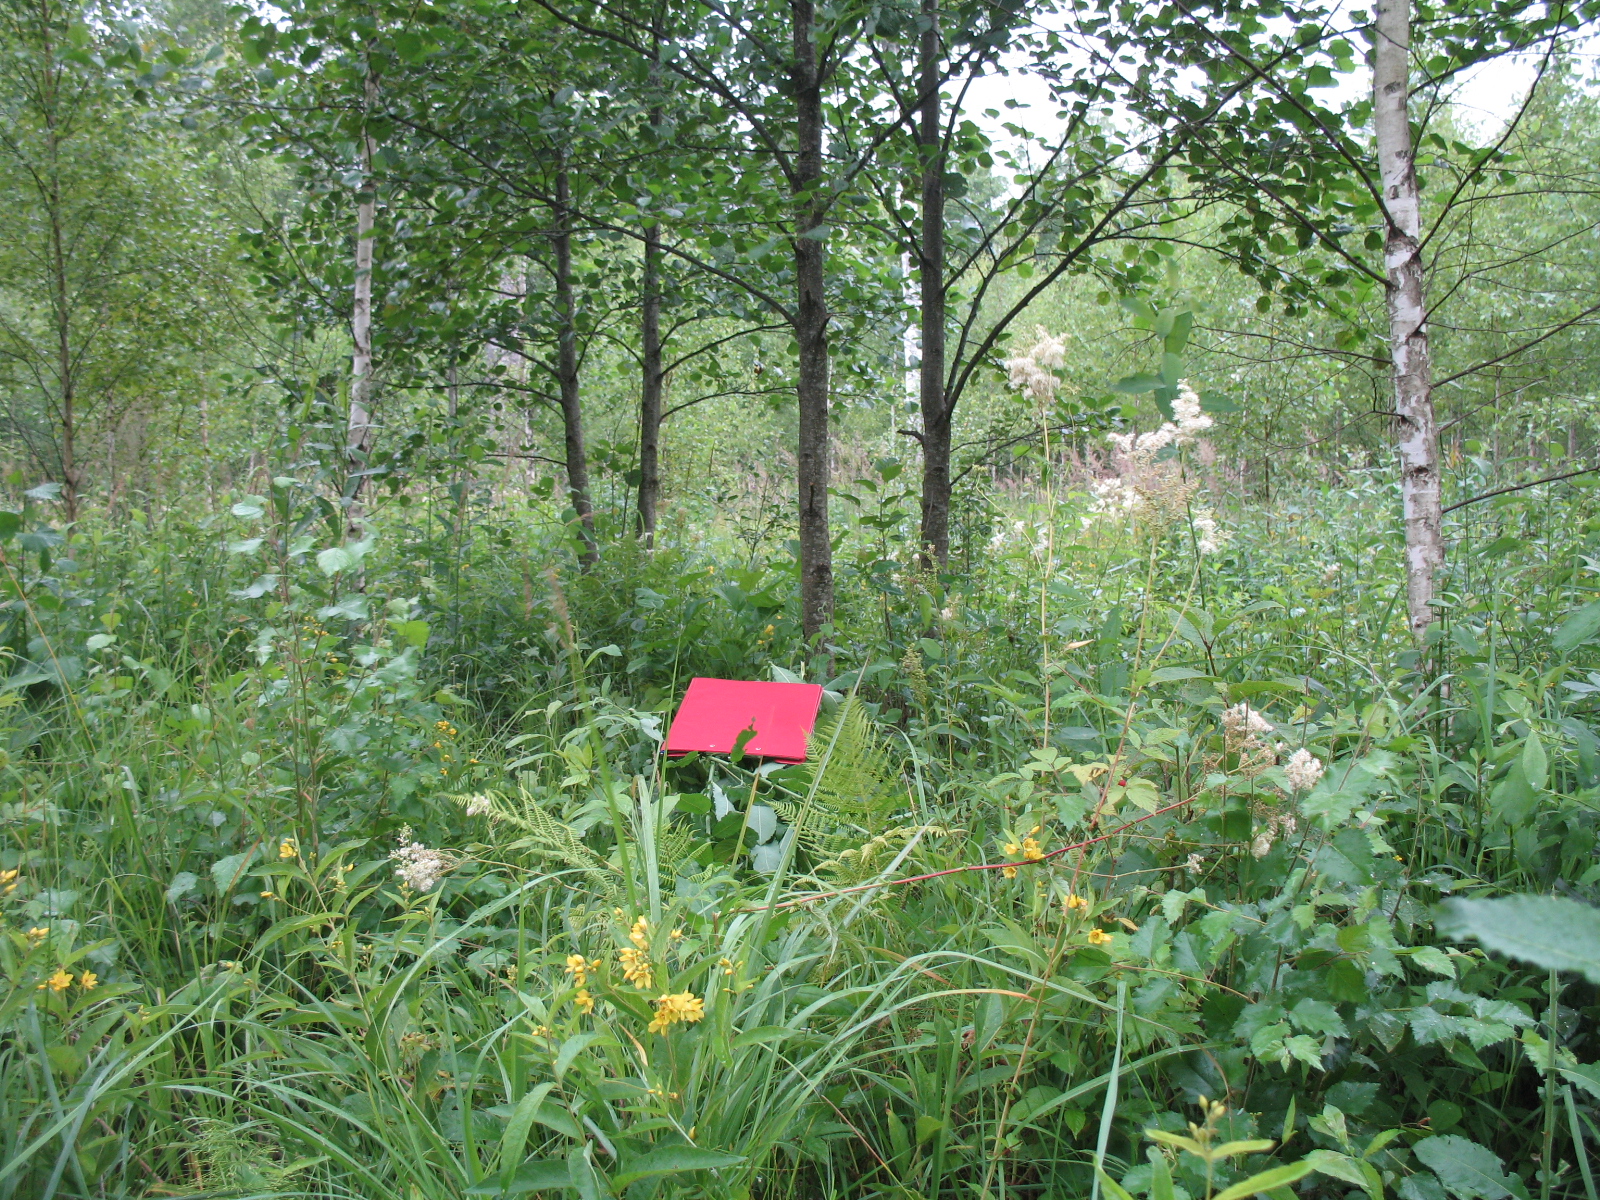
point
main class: Woodland
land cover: Broadleaved woodland
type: non-riverine alder, birch or aspen forest
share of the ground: 50 - 75 %
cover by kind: broadleaved forest trees 60 %, herbaceous plants 40 %
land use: Forestry
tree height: > 5 m
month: July
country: LV
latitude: 56.3387
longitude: 25.0404
